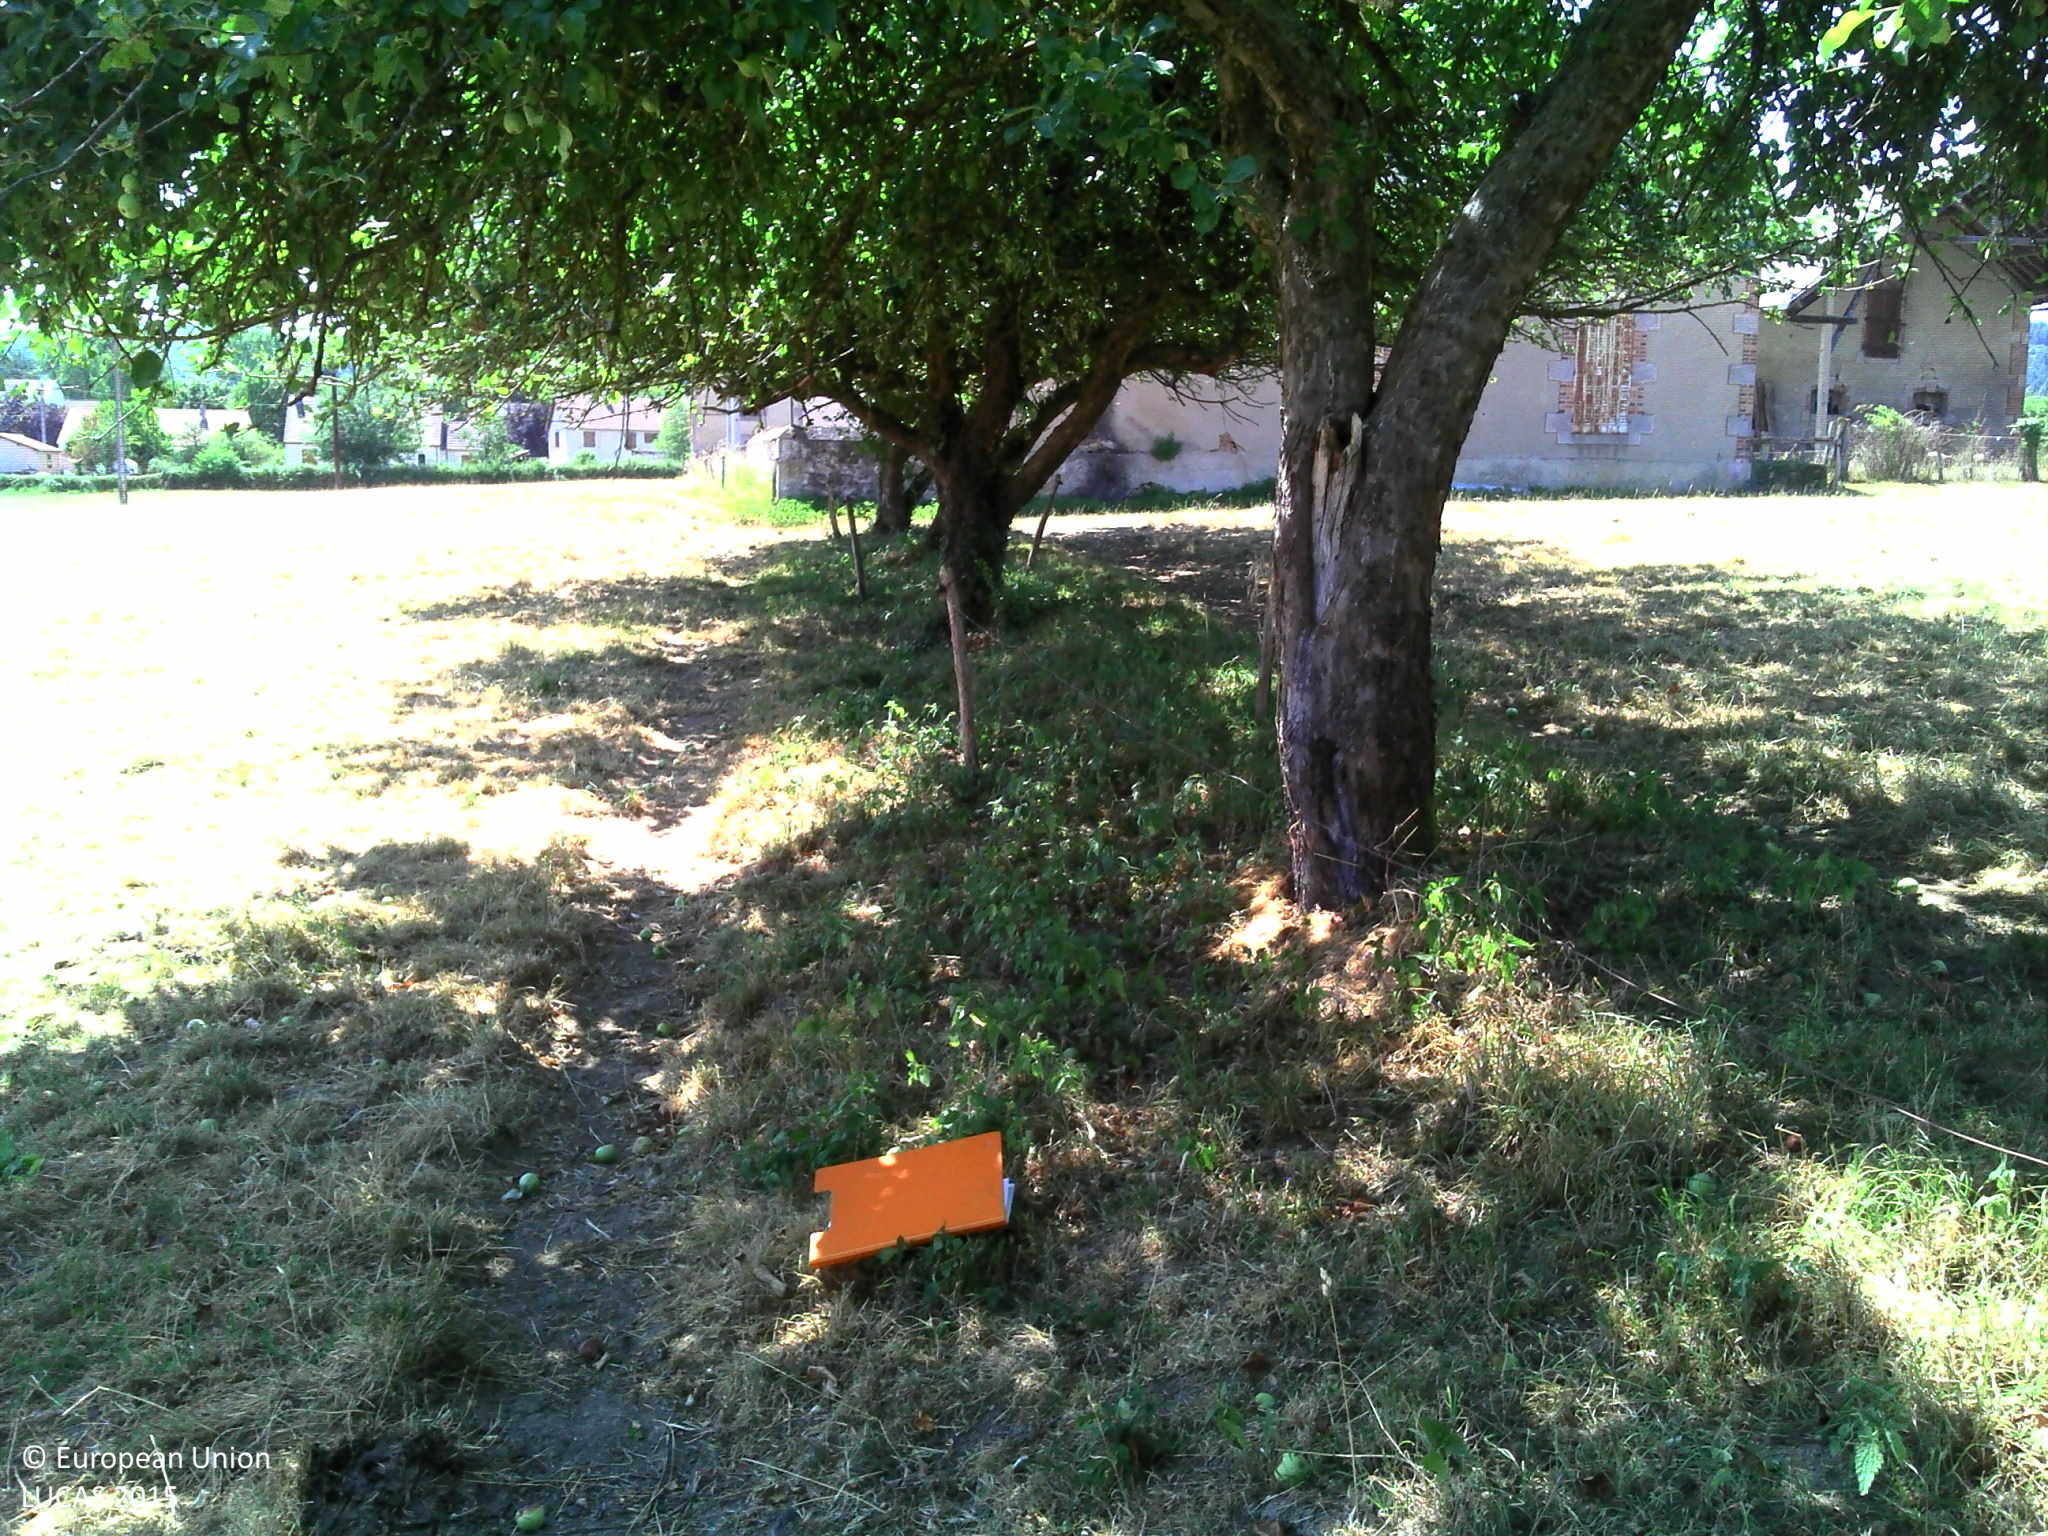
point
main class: Cropland
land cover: Apple fruit
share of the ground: 50 - 75 %
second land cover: Grassland without tree/shrub cover
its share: 25 - 50 %
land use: Agriculture (excluding fallow land and kitchen gardens)
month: July
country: FR
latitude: 46.7945
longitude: 3.9598
